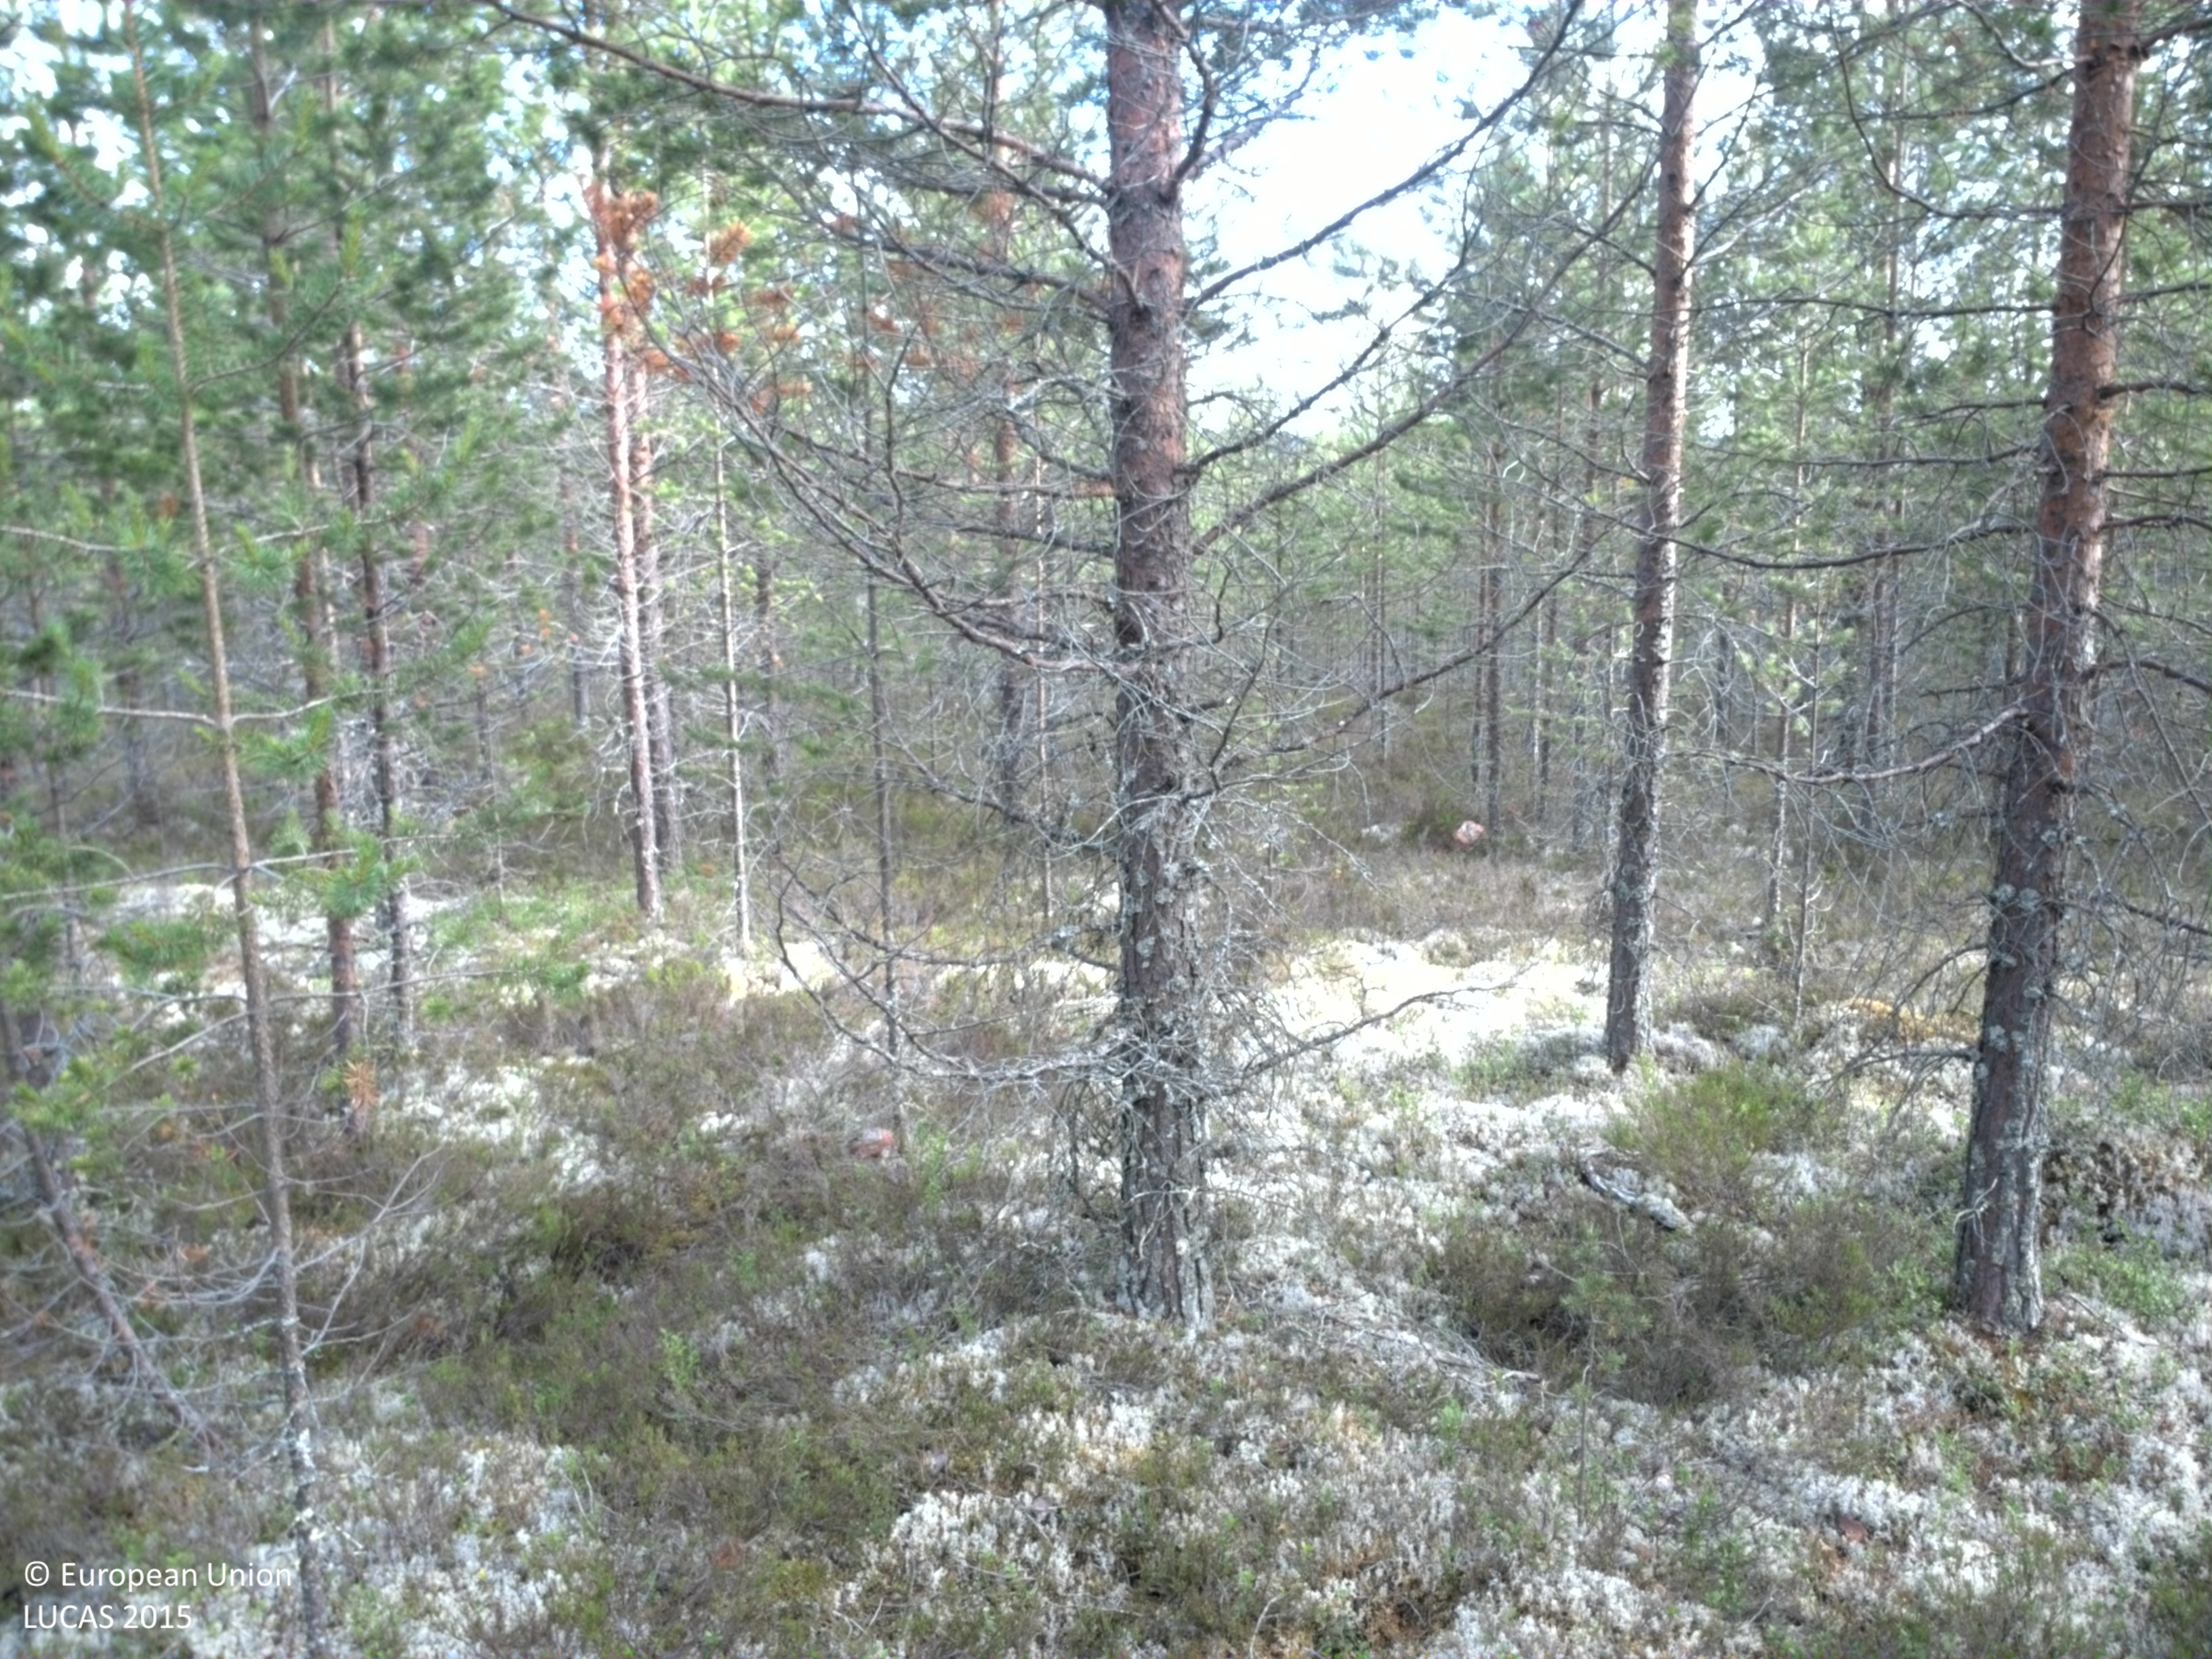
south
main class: Woodland
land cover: Pine dominated coniferous woodland
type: boreal forest
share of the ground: 50 - 75 %
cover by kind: coniferous forest trees 60 %, shrubs 20 %, lichens and mosses 20 %
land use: Forestry
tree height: < 5 m
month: July
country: SE
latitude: 61.5045
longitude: 13.6133
